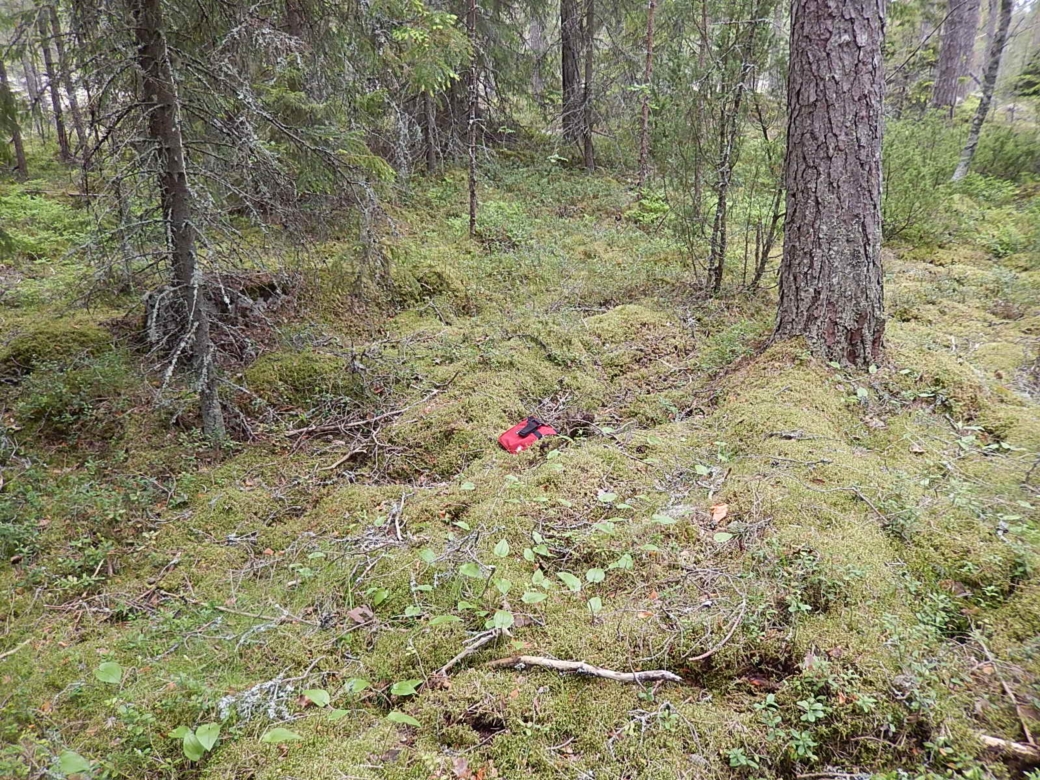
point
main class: Woodland
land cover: Other coniferous woodland
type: boreal forest
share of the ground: > 75 %
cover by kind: coniferous forest trees 80 %, lichens and mosses 10 %, broadleaved forest trees 5 %, shrubs 5 %
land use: Forestry
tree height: > 5 m
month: June
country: FI
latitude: 61.8003
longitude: 21.5638
